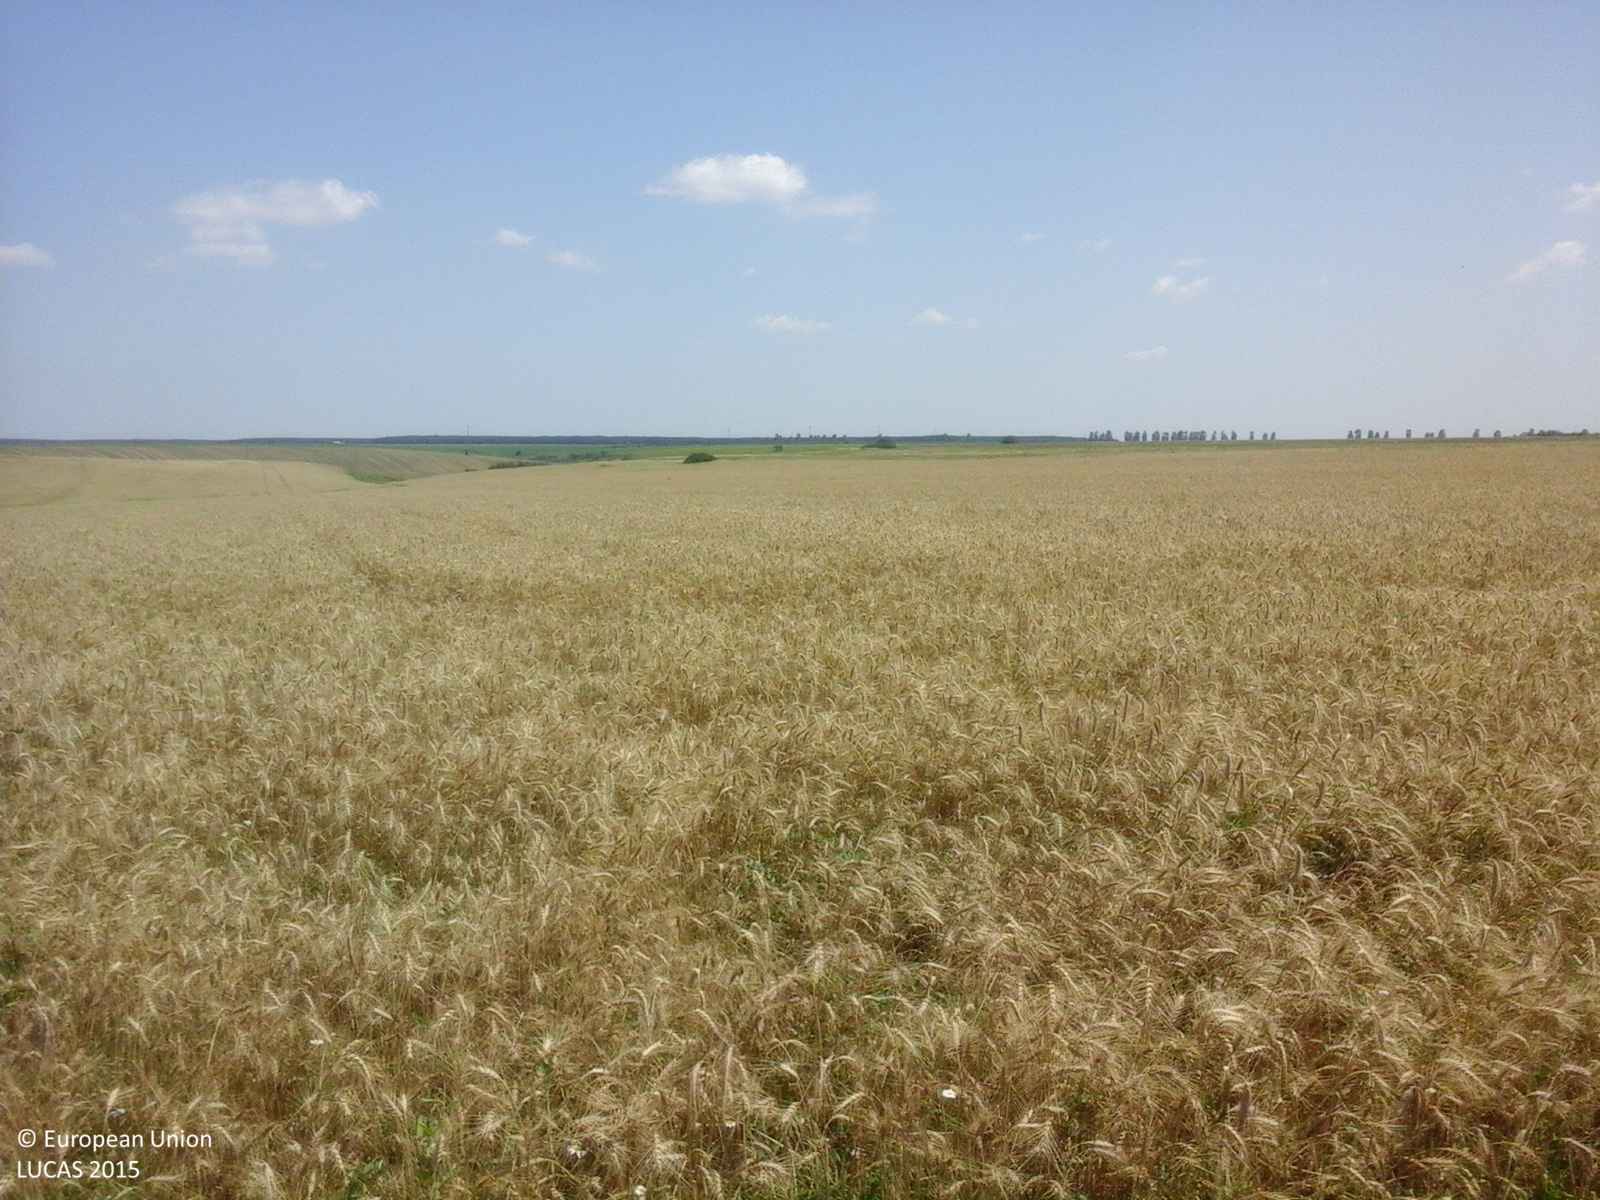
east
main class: Cropland
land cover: Common wheat
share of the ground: > 75 %
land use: Agriculture (excluding fallow land and kitchen gardens)
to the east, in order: Common wheat
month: July
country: RO
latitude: 44.4271
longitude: 24.6059
